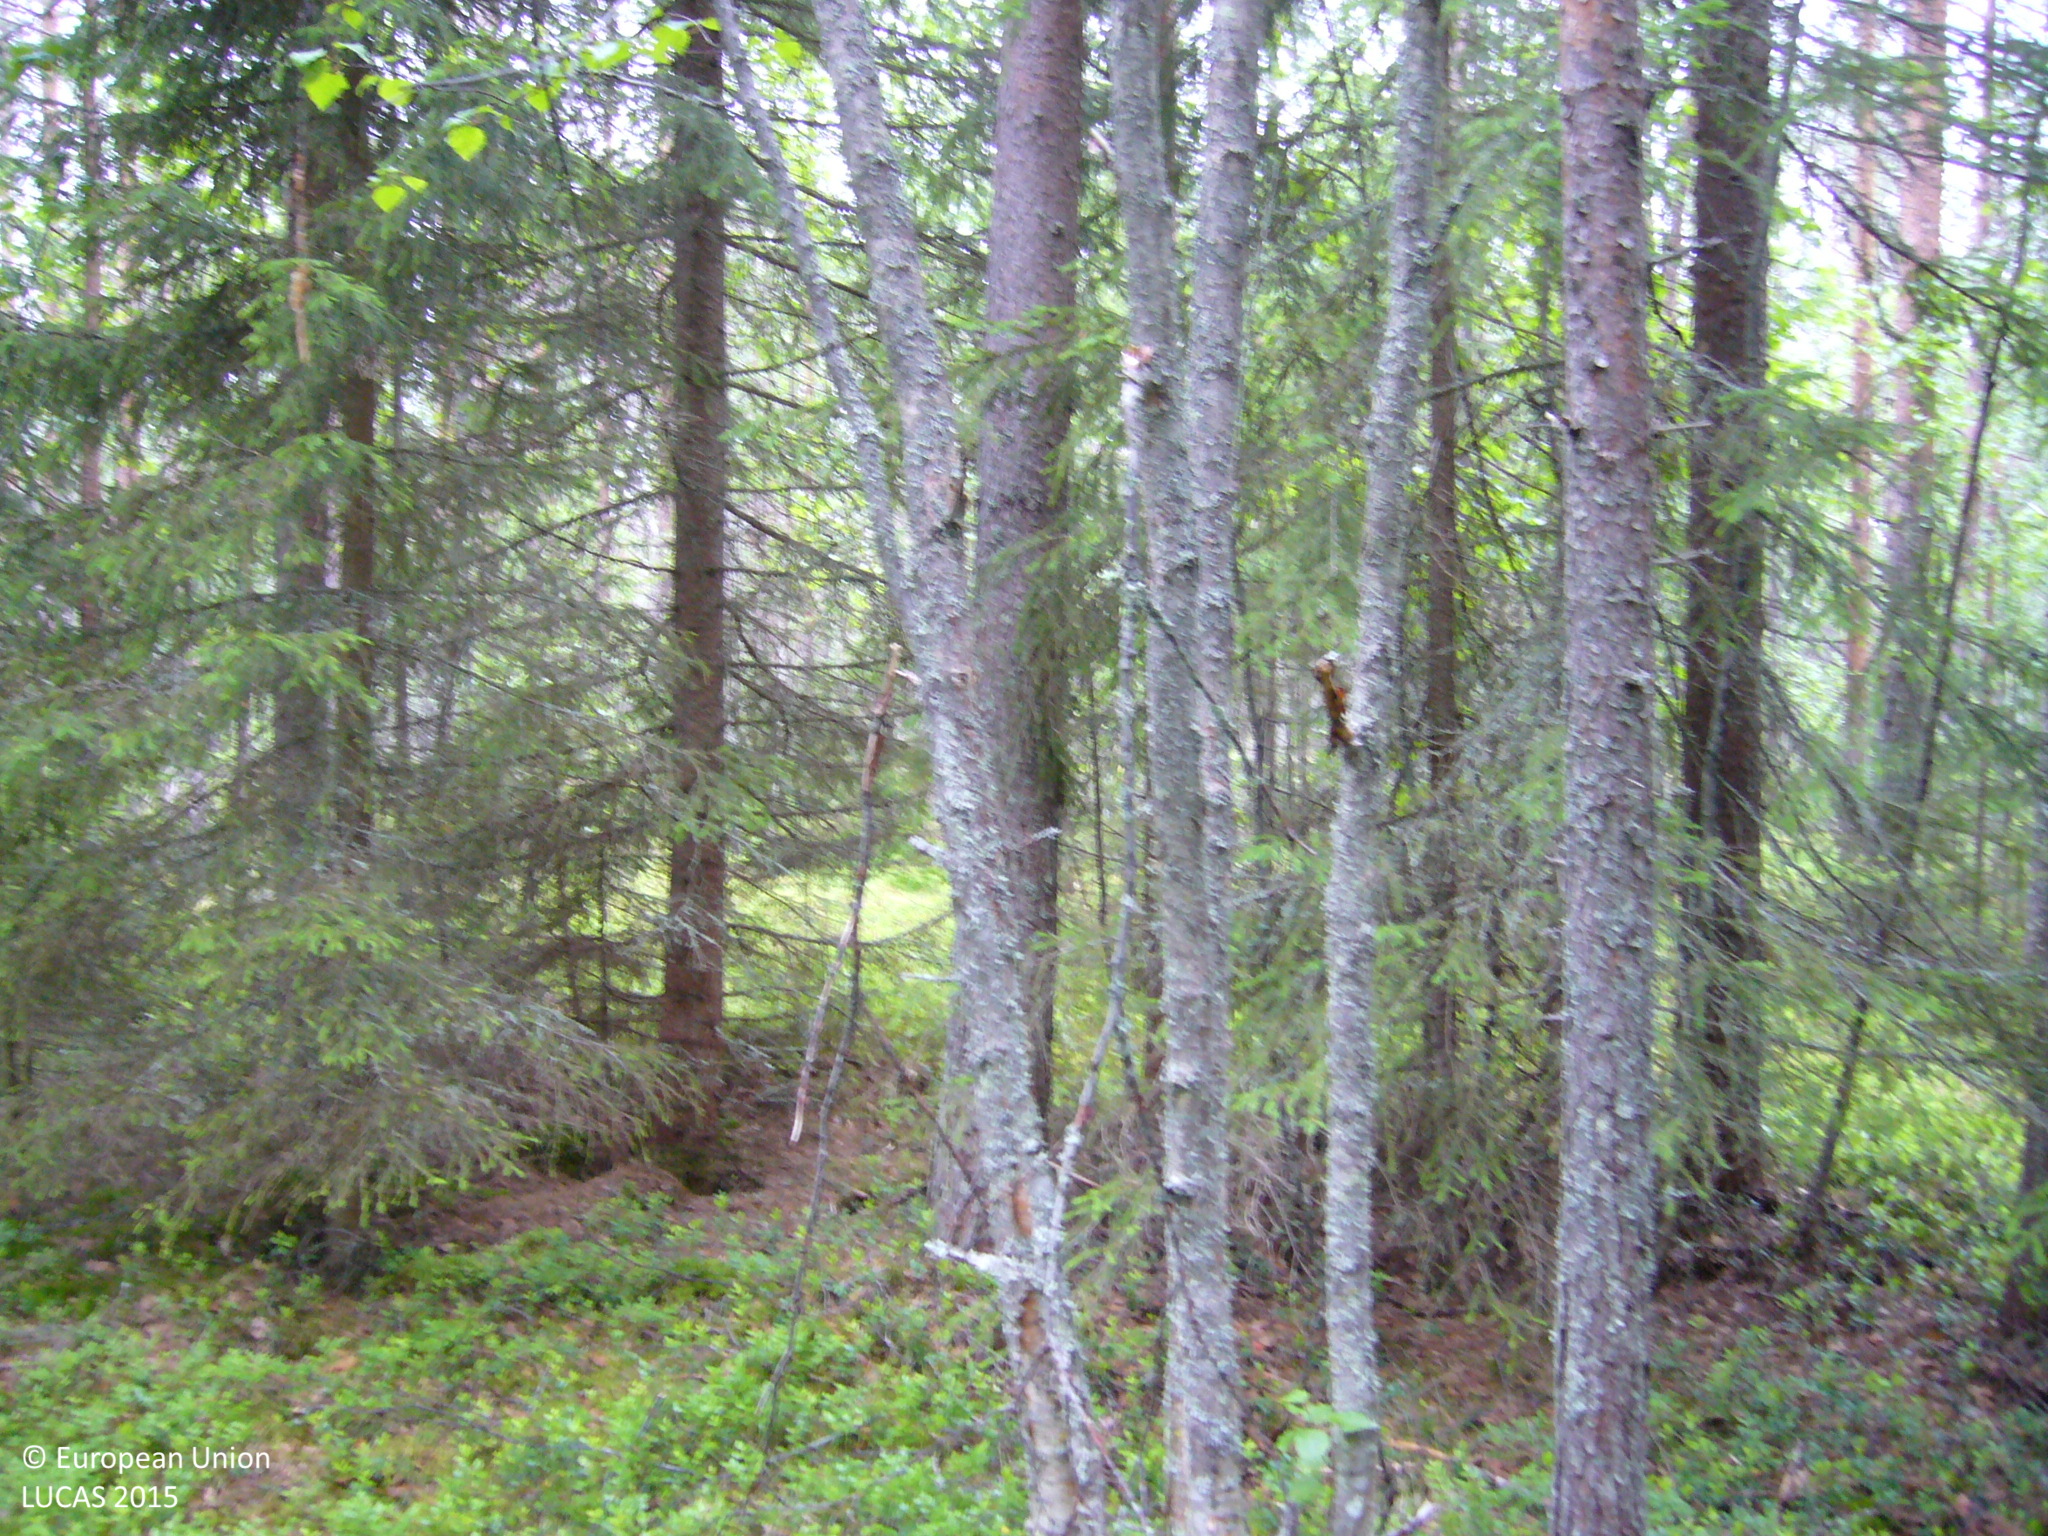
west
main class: Woodland
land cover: Pine dominated mixed woodland
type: boreal forest
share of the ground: > 75 %
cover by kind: coniferous forest trees 50 %, broadleaved forest trees 25 %, shrubs 25 %
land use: Forestry
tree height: > 5 m
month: July
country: FI
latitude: 63.4275
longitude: 26.3741
